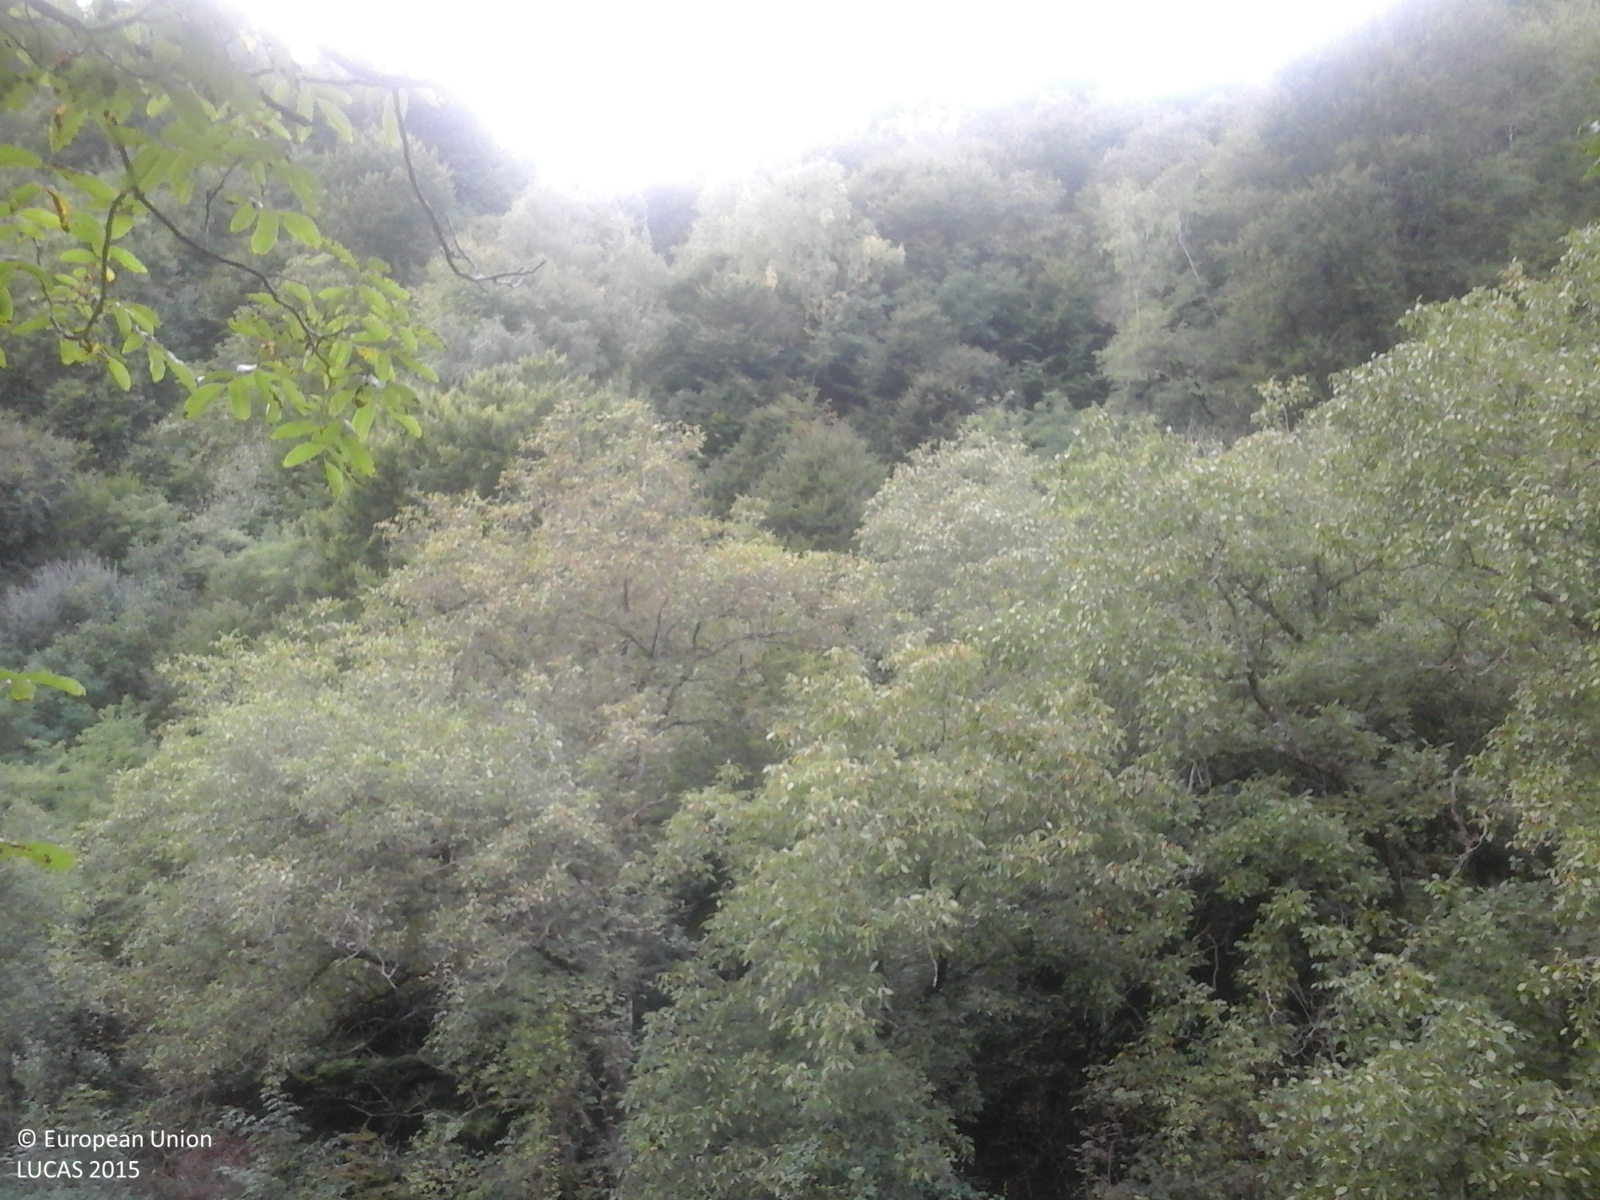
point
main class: Woodland
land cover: Broadleaved woodland
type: acidophilous oak and oak-birch forest
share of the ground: > 75 %
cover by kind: broadleaved forest trees 100 %
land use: Forestry
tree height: > 5 m
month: September
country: RO
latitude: 45.7925
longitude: 22.3825
